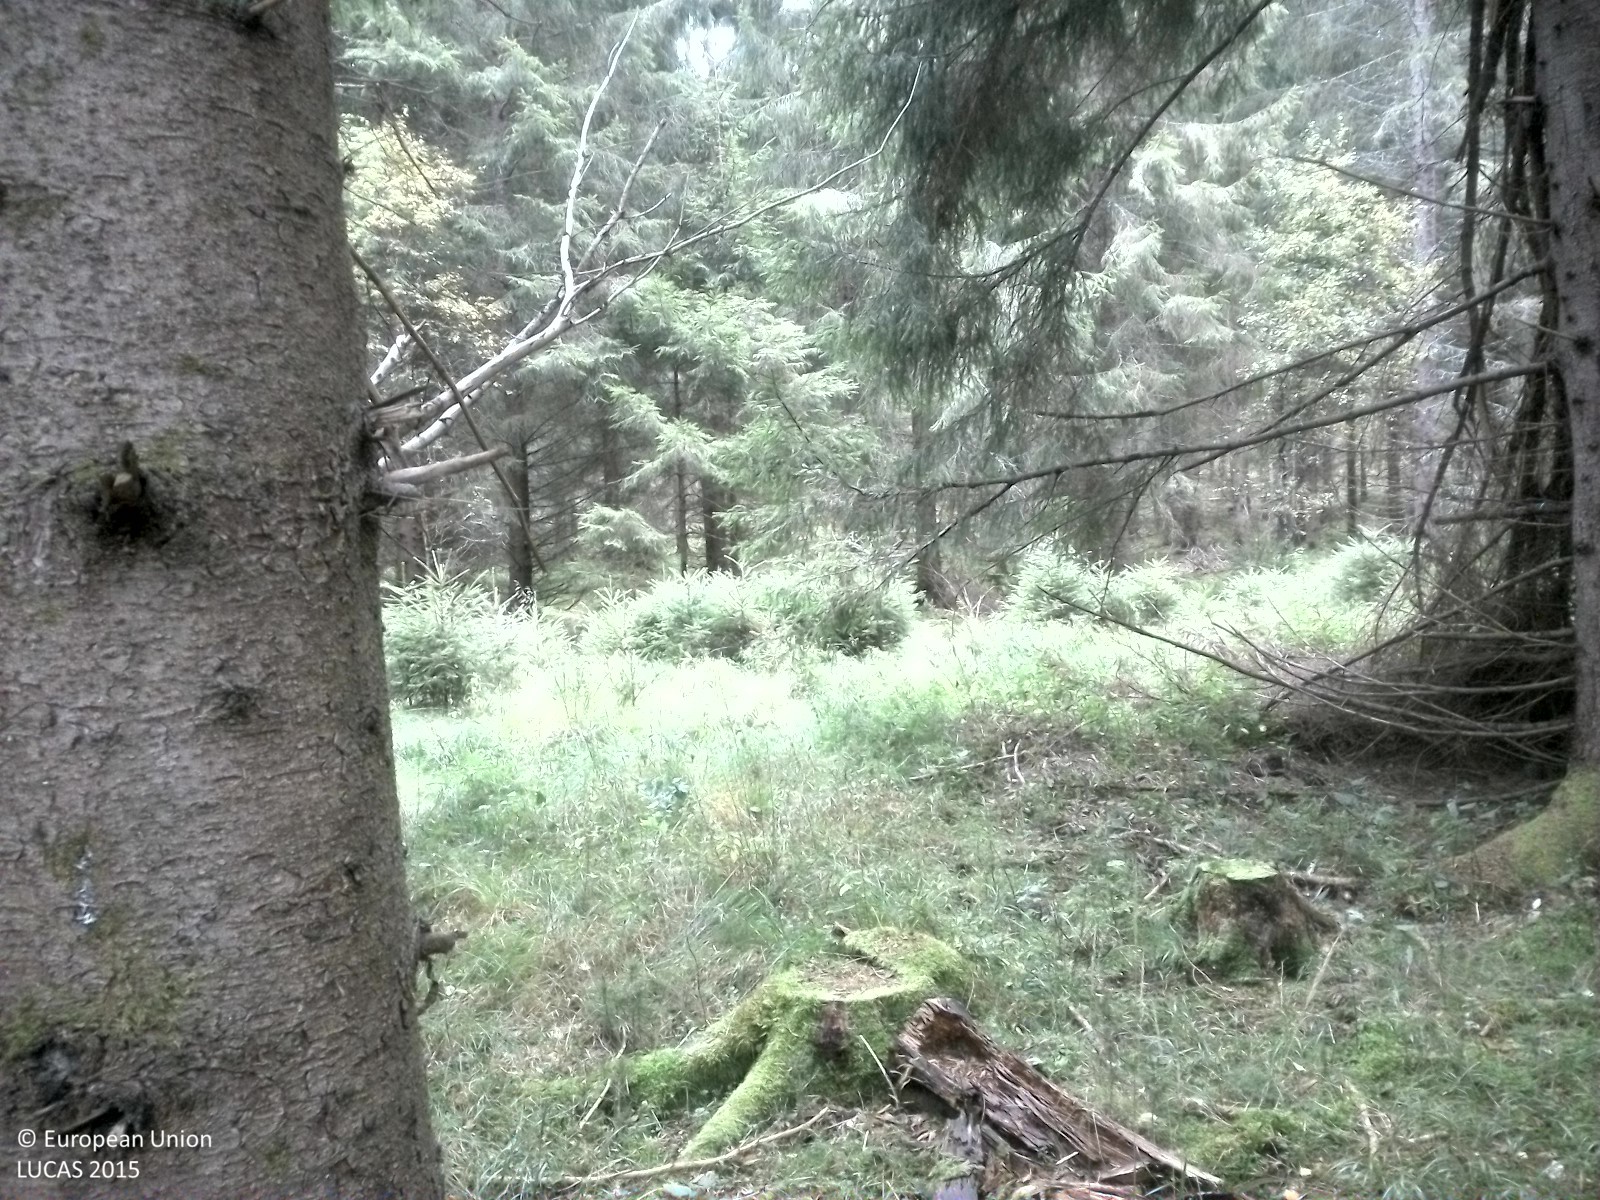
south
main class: Woodland
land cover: Spruce dominated coniferous woodland
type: boreal forest
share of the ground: 50 - 75 %
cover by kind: coniferous forest trees 60 %, lichens and mosses 20 %, herbaceous plants 10 %, unconsolidated bare surface 10 %
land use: Forestry
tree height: > 5 m
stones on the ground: < 10 %
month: September
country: SE
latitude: 58.9073
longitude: 15.7744
